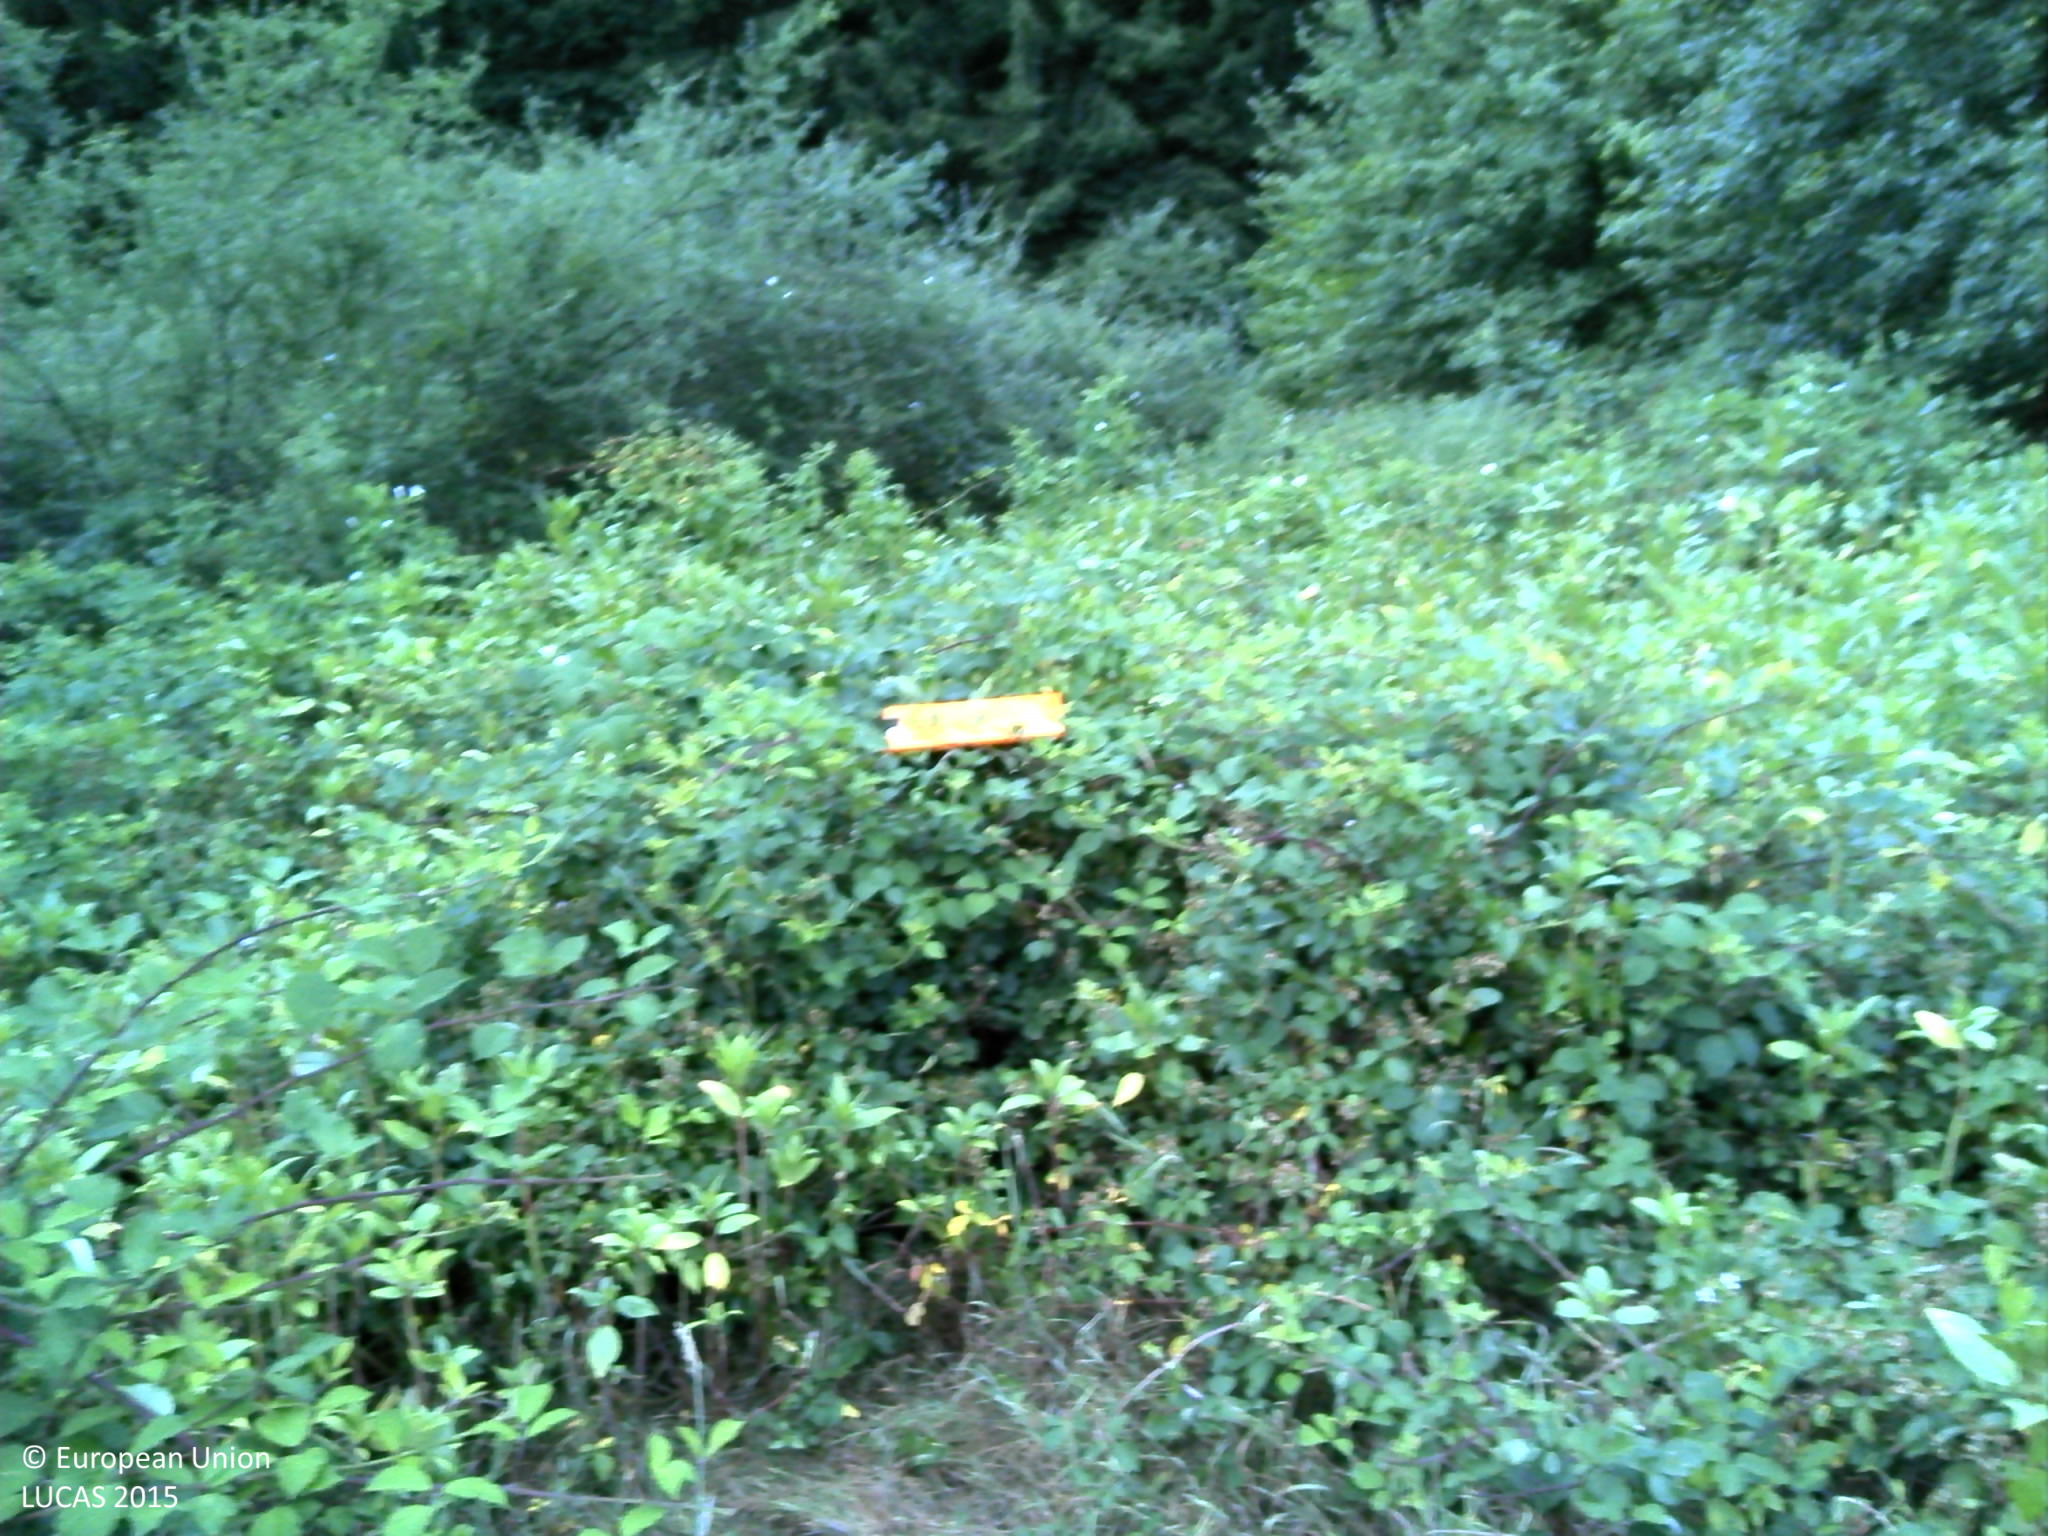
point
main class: Shrubland
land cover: Shrubland with sparse tree cover
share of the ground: > 75 %
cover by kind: shrubs 95 %, broadleaved forest trees 5 %
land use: Semi-natural and natural areas not in use
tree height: < 5 m
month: July
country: FR
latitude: 48.0520
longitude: 6.2577
